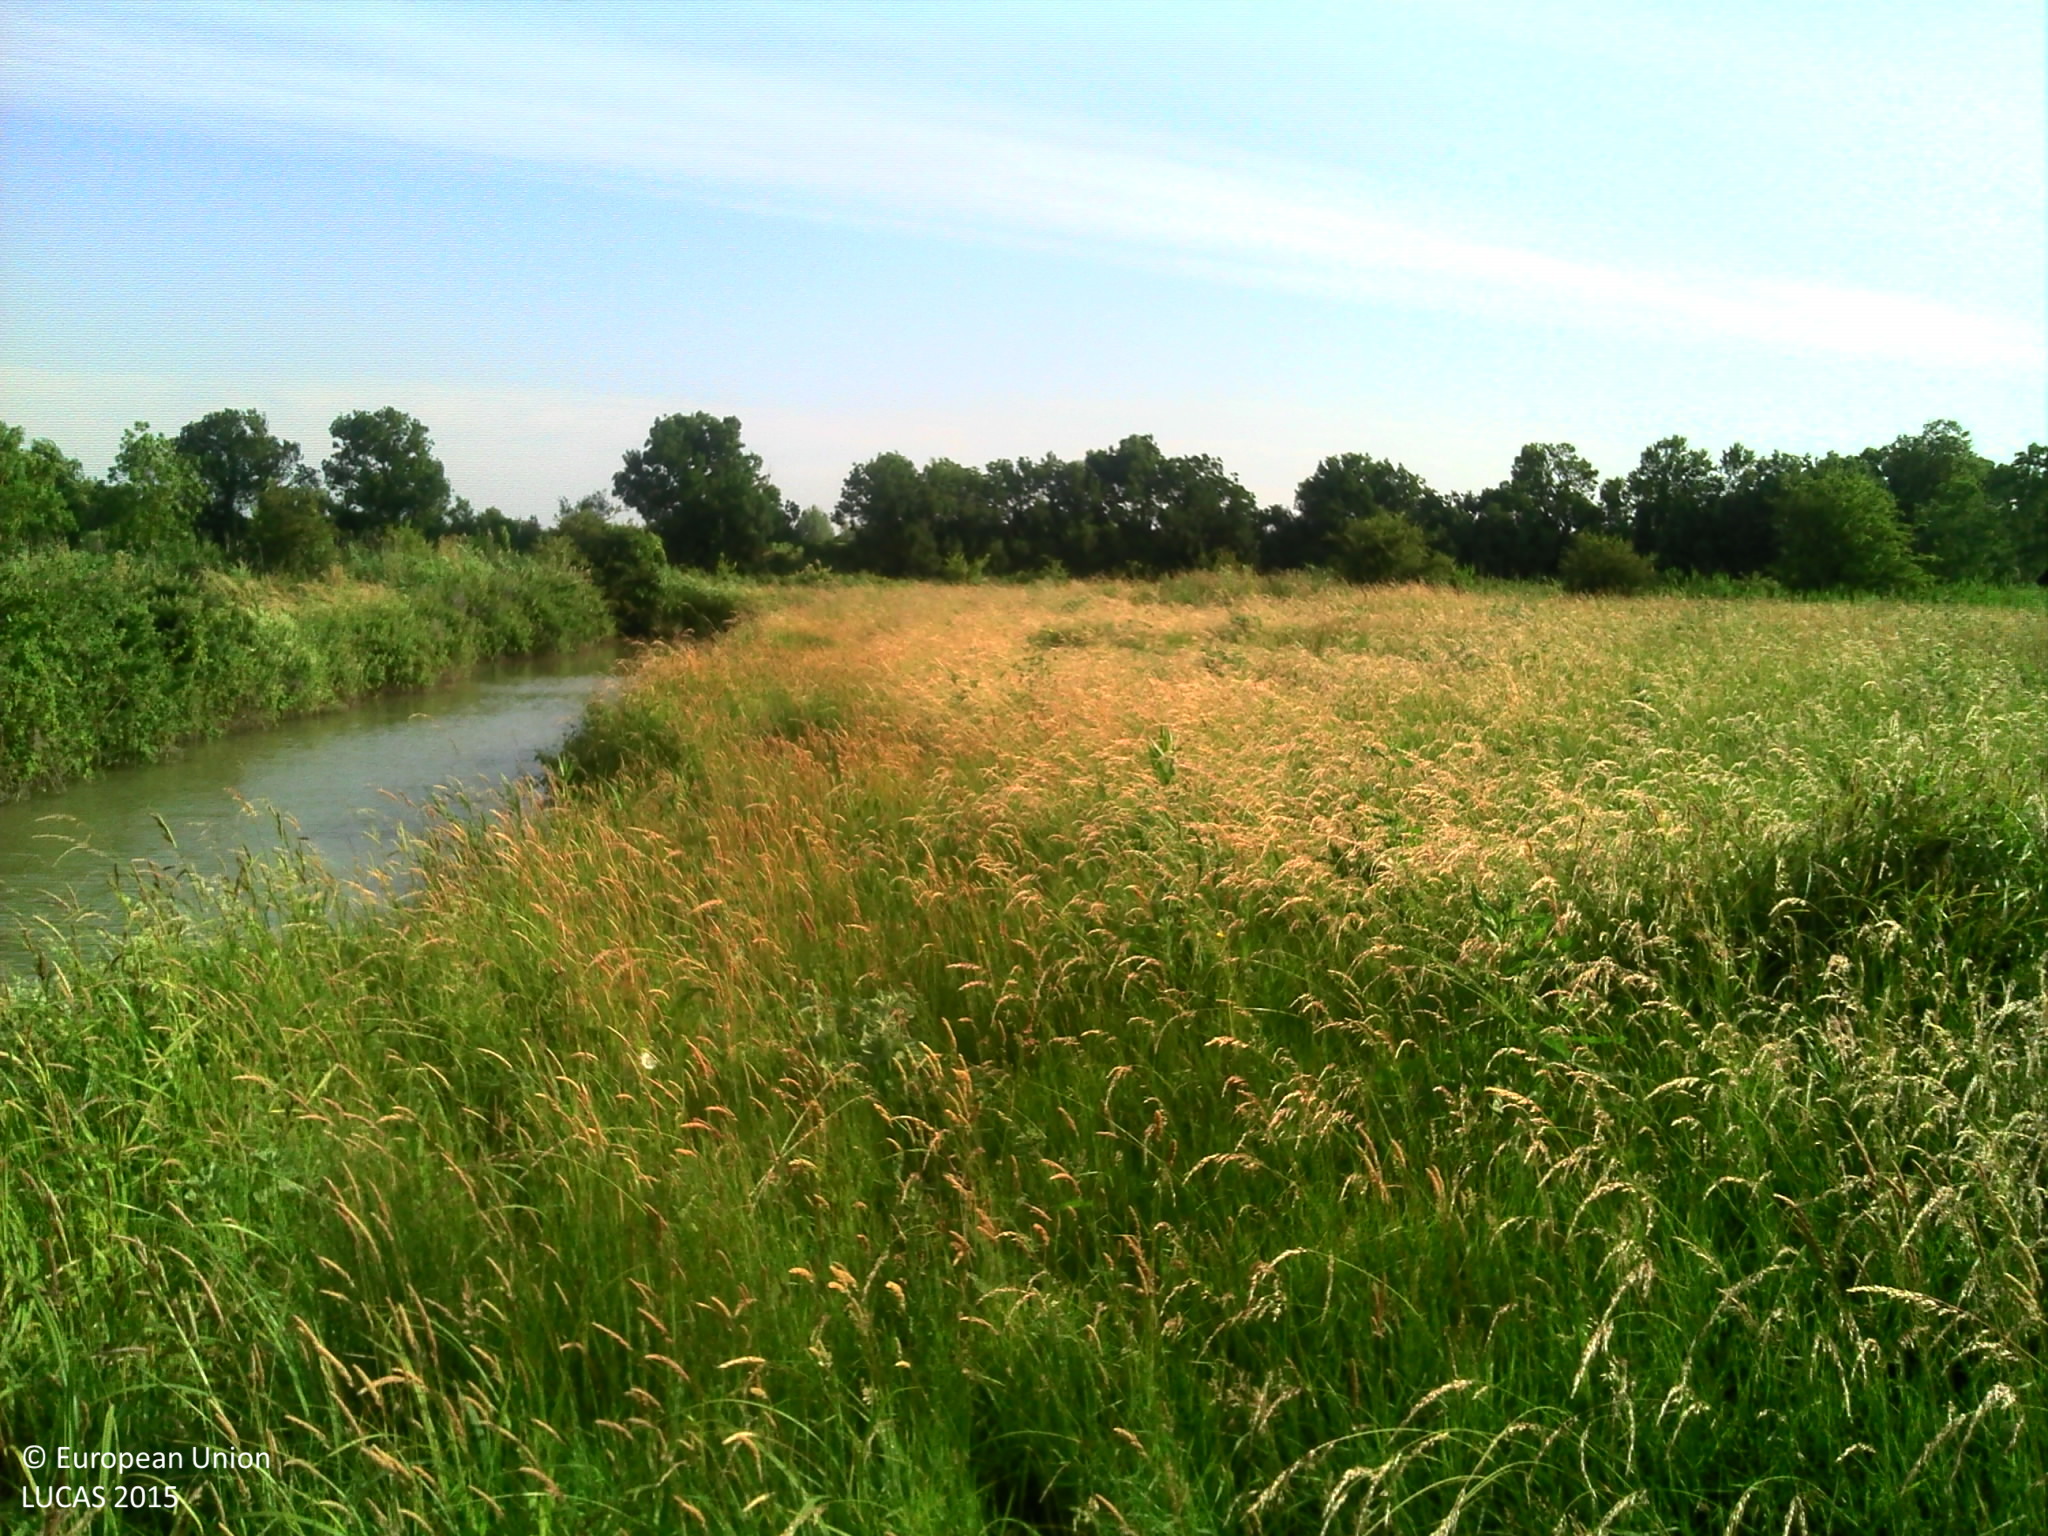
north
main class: Grassland
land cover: Grassland without tree/shrub cover
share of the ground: > 75 %
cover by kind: herbaceous plants 95 %, shrubs 5 %
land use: Agriculture (excluding fallow land and kitchen gardens)
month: June
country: FR
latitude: 46.0365
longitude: -0.9994
